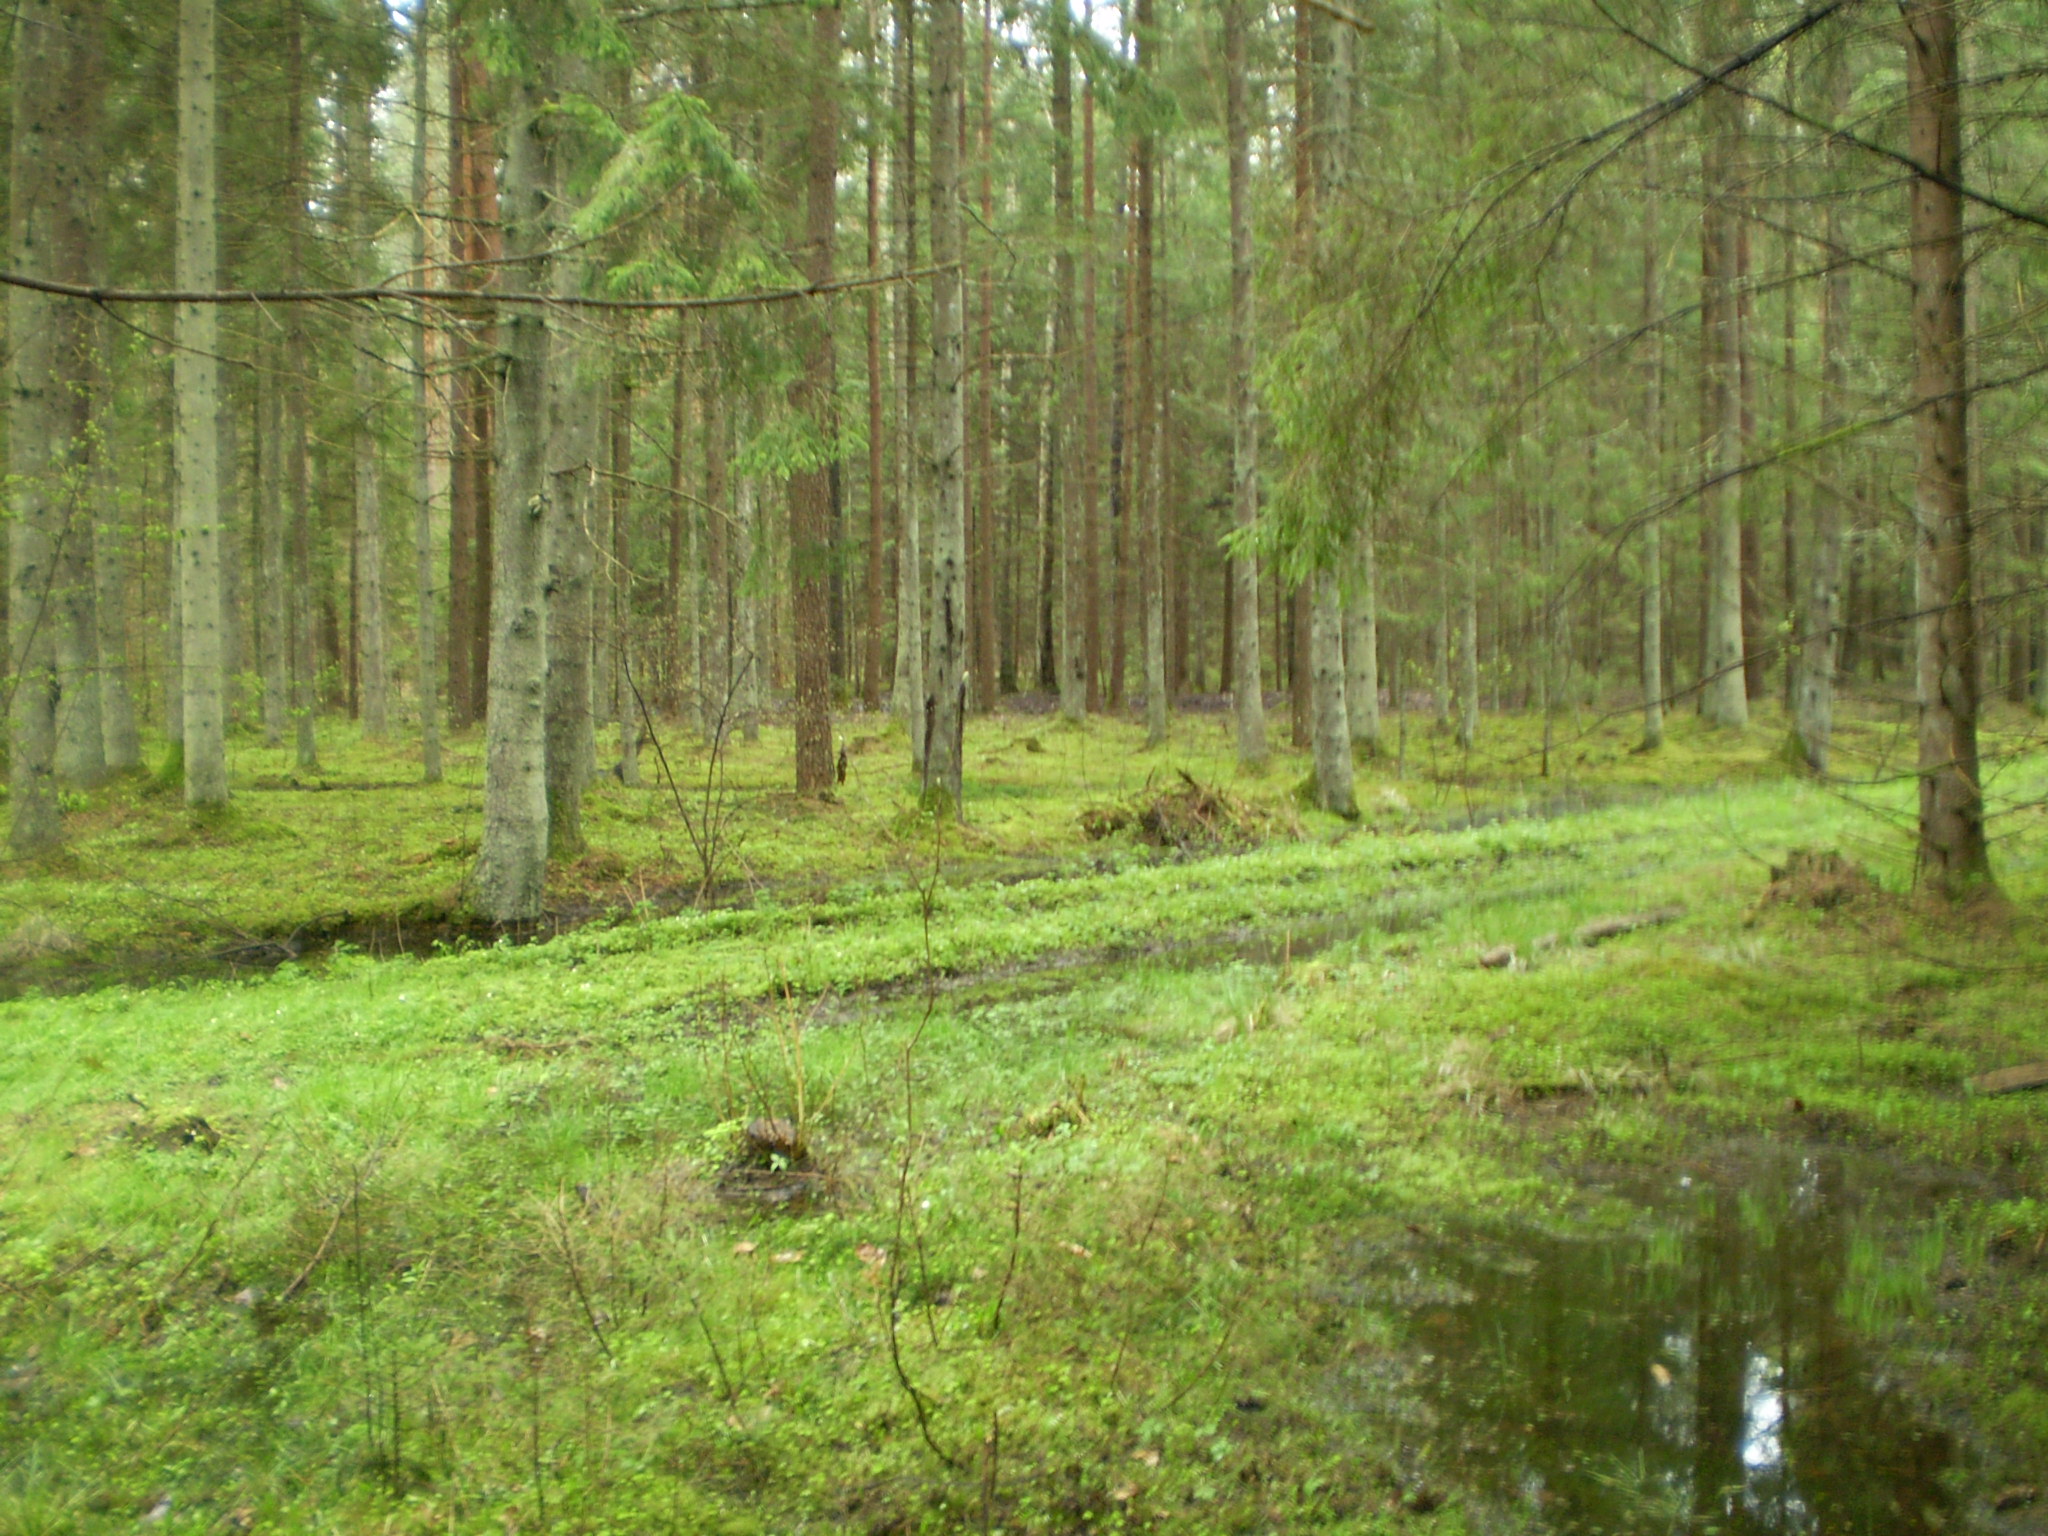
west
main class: Woodland
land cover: Spruce dominated coniferous woodland
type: hemiboreal forest and nemoral coniferous forest and mixed broadleaved-coniferous forest
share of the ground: > 75 %
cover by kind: coniferous forest trees 100 %
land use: Forestry
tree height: > 5 m
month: May
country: LT
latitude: 56.3021
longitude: 22.1245
